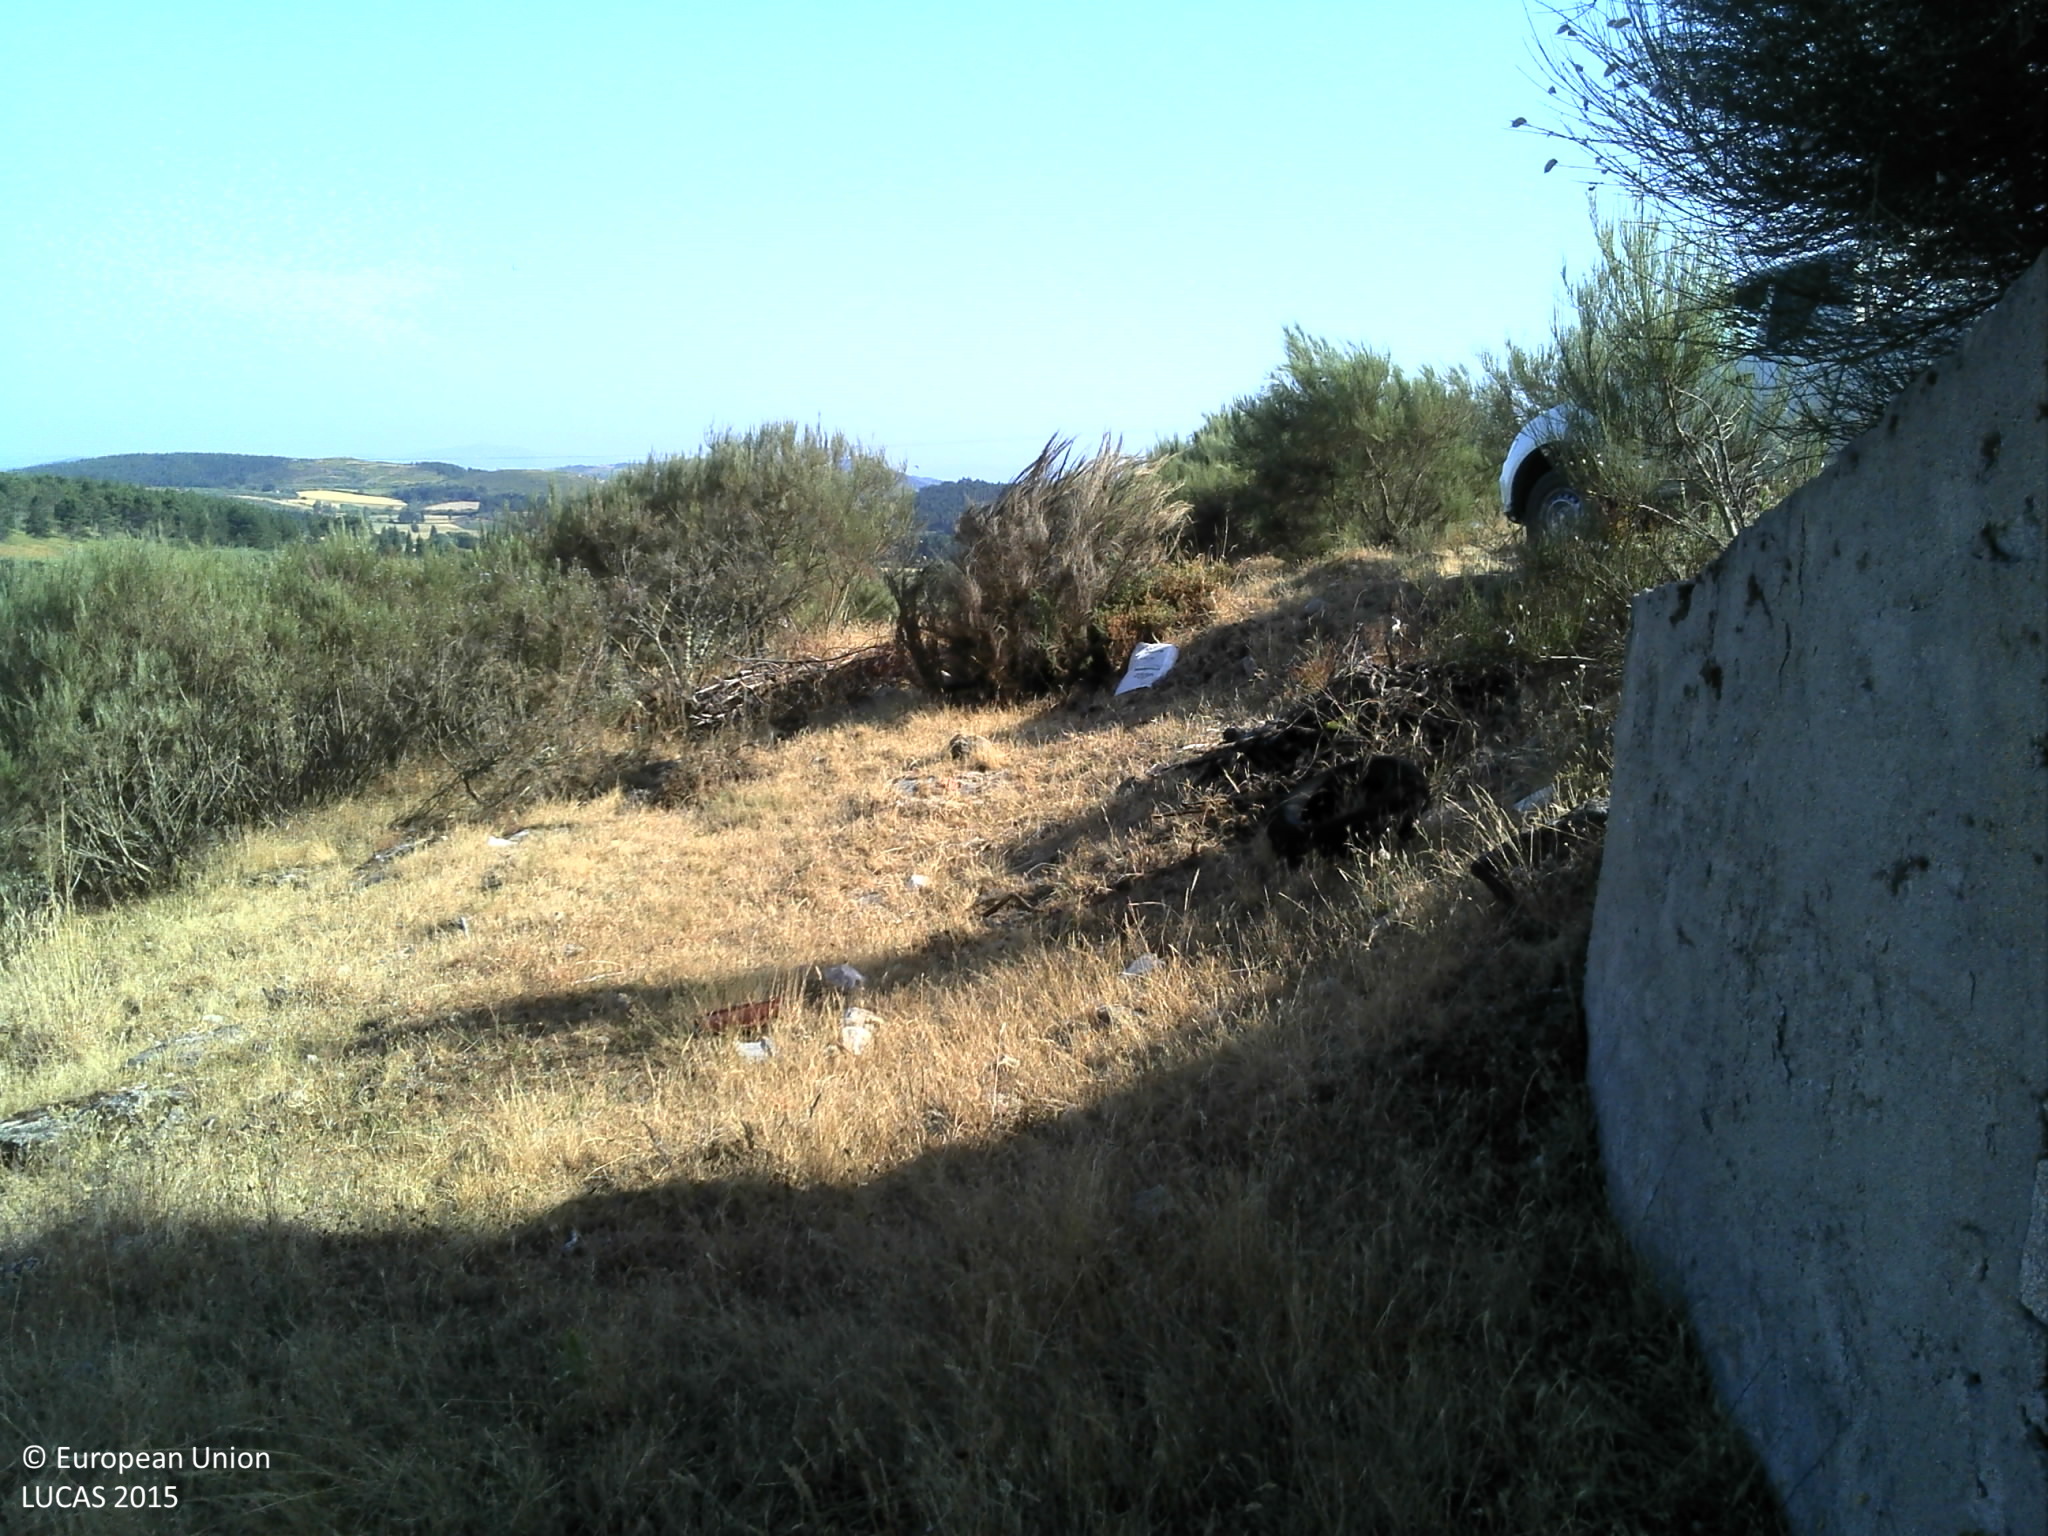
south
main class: Grassland
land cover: Grassland without tree/shrub cover
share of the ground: > 75 %
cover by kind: herbaceous plants 75 %, unconsolidated bare surface 20 %, shrubs 5 %
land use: Agriculture (excluding fallow land and kitchen gardens)
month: July
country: PT
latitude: 41.7135
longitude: -7.7697
